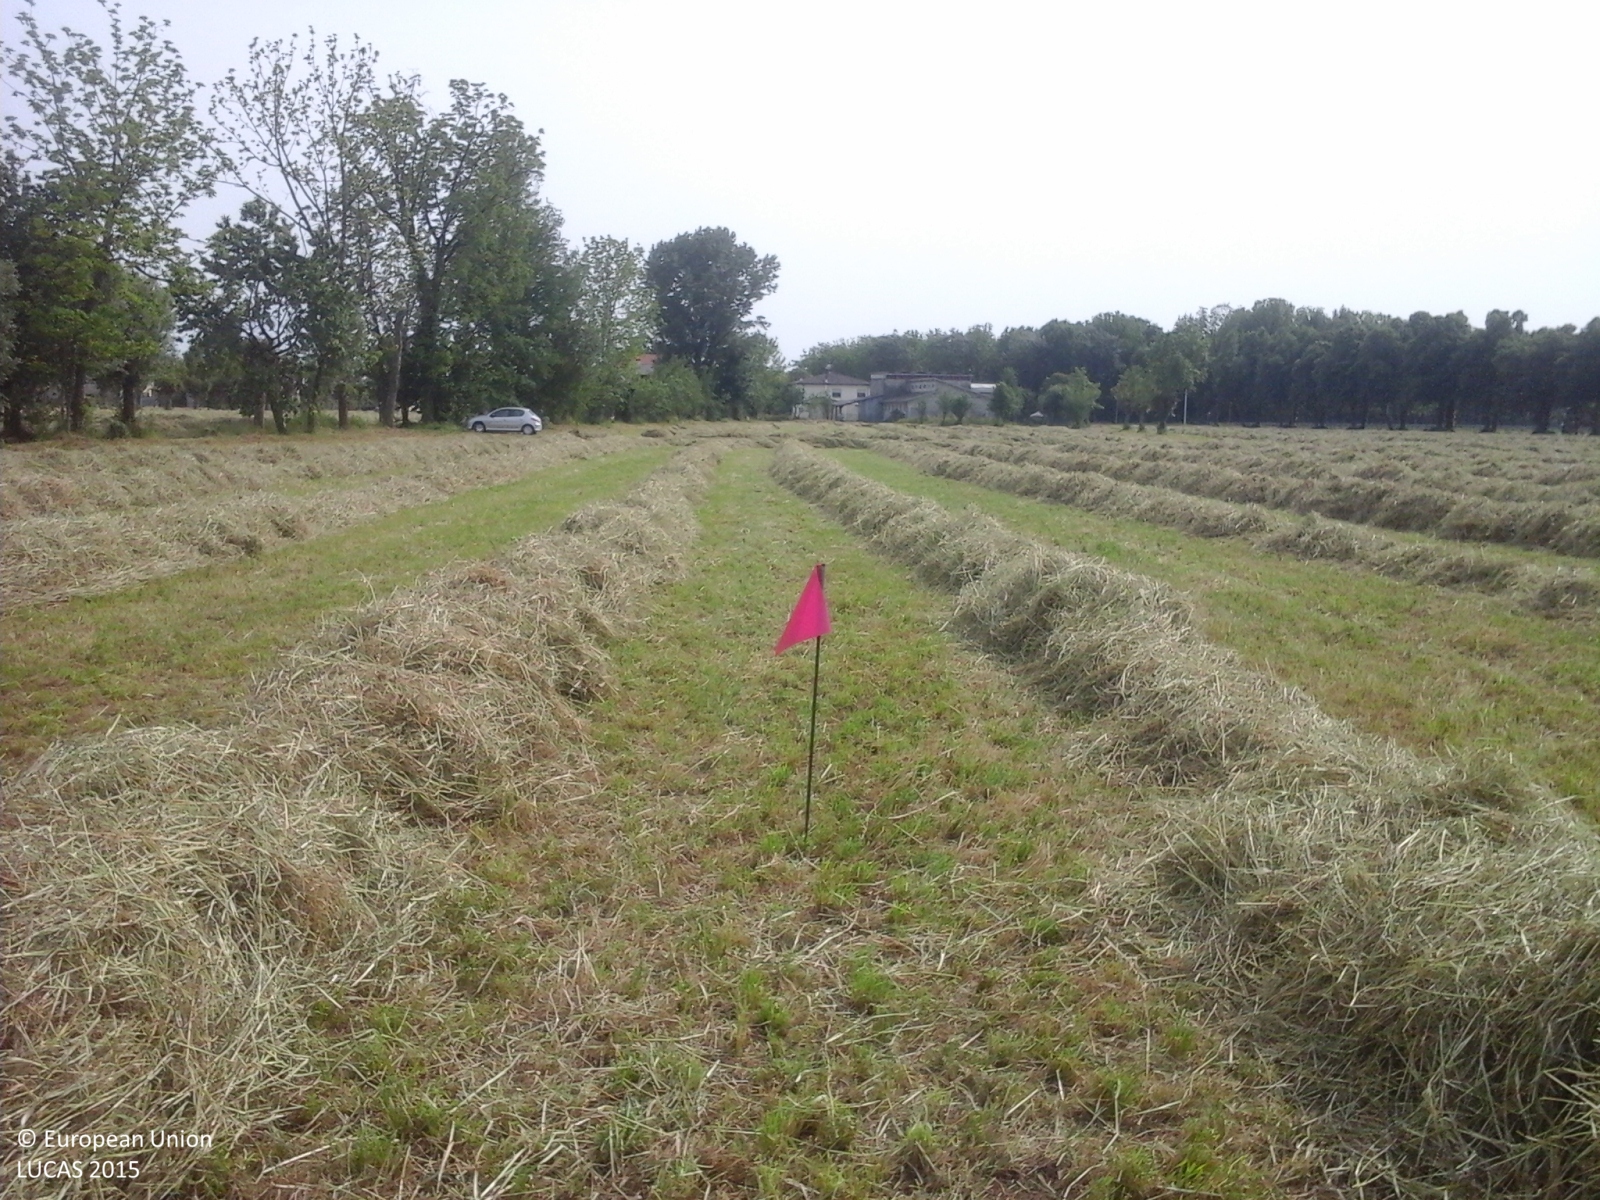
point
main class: Cropland
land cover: Temporary grasslands
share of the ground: > 75 %
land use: Agriculture (excluding fallow land and kitchen gardens)
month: May
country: IT
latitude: 45.6537
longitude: 11.6528
